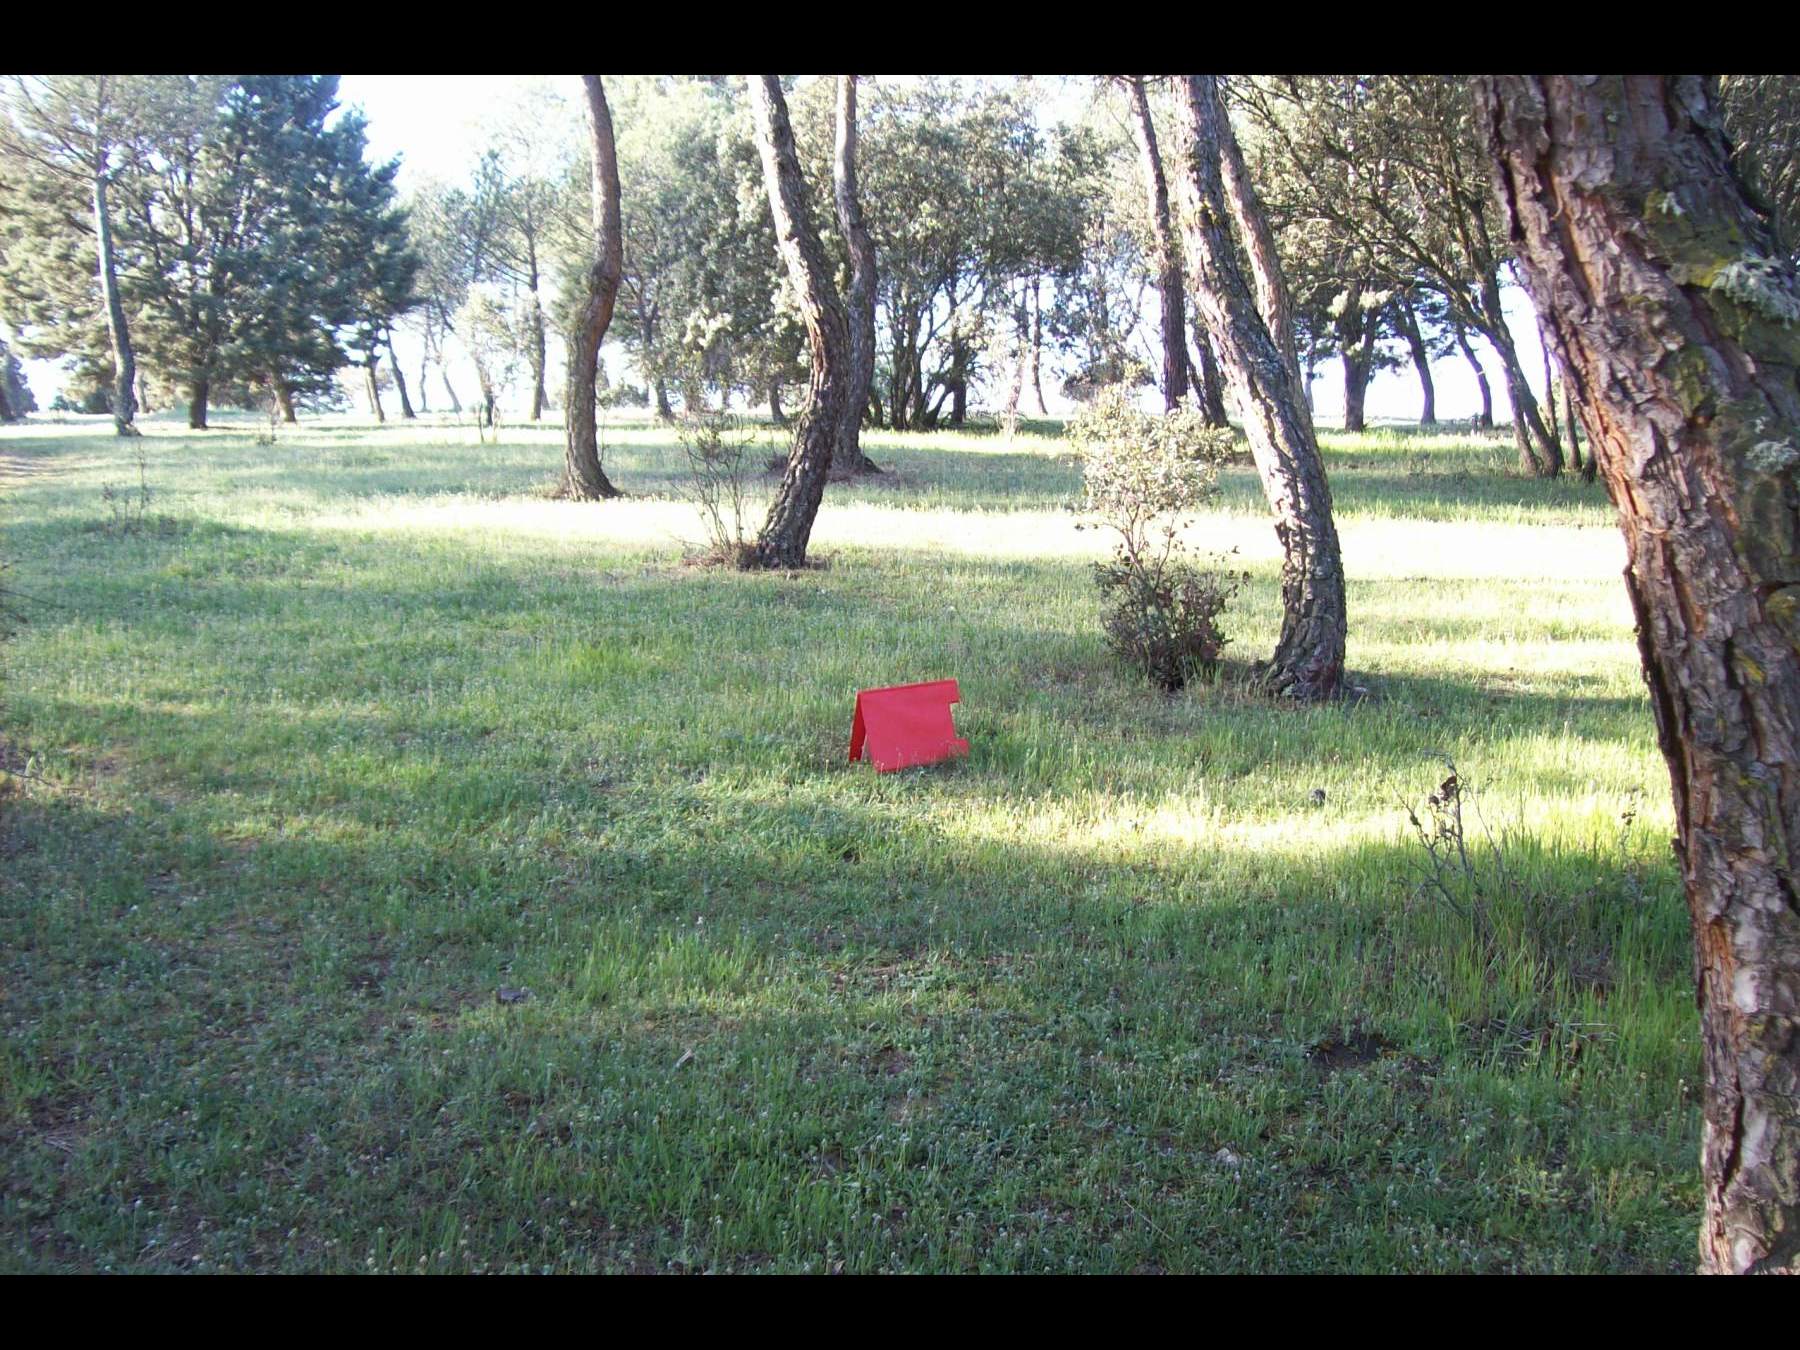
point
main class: Woodland
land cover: Pine dominated mixed woodland
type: coniferous forest of the mediterranean region
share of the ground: 50 - 75 %
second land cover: Grassland without tree/shrub cover
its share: > 75 %
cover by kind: coniferous forest trees 60 %, broadleaved forest trees 25 %, herbaceous plants 10 %
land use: Amenities, museums, leisure
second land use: Sport
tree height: < 5 m
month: April
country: ES
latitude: 40.4304
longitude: -3.7473
